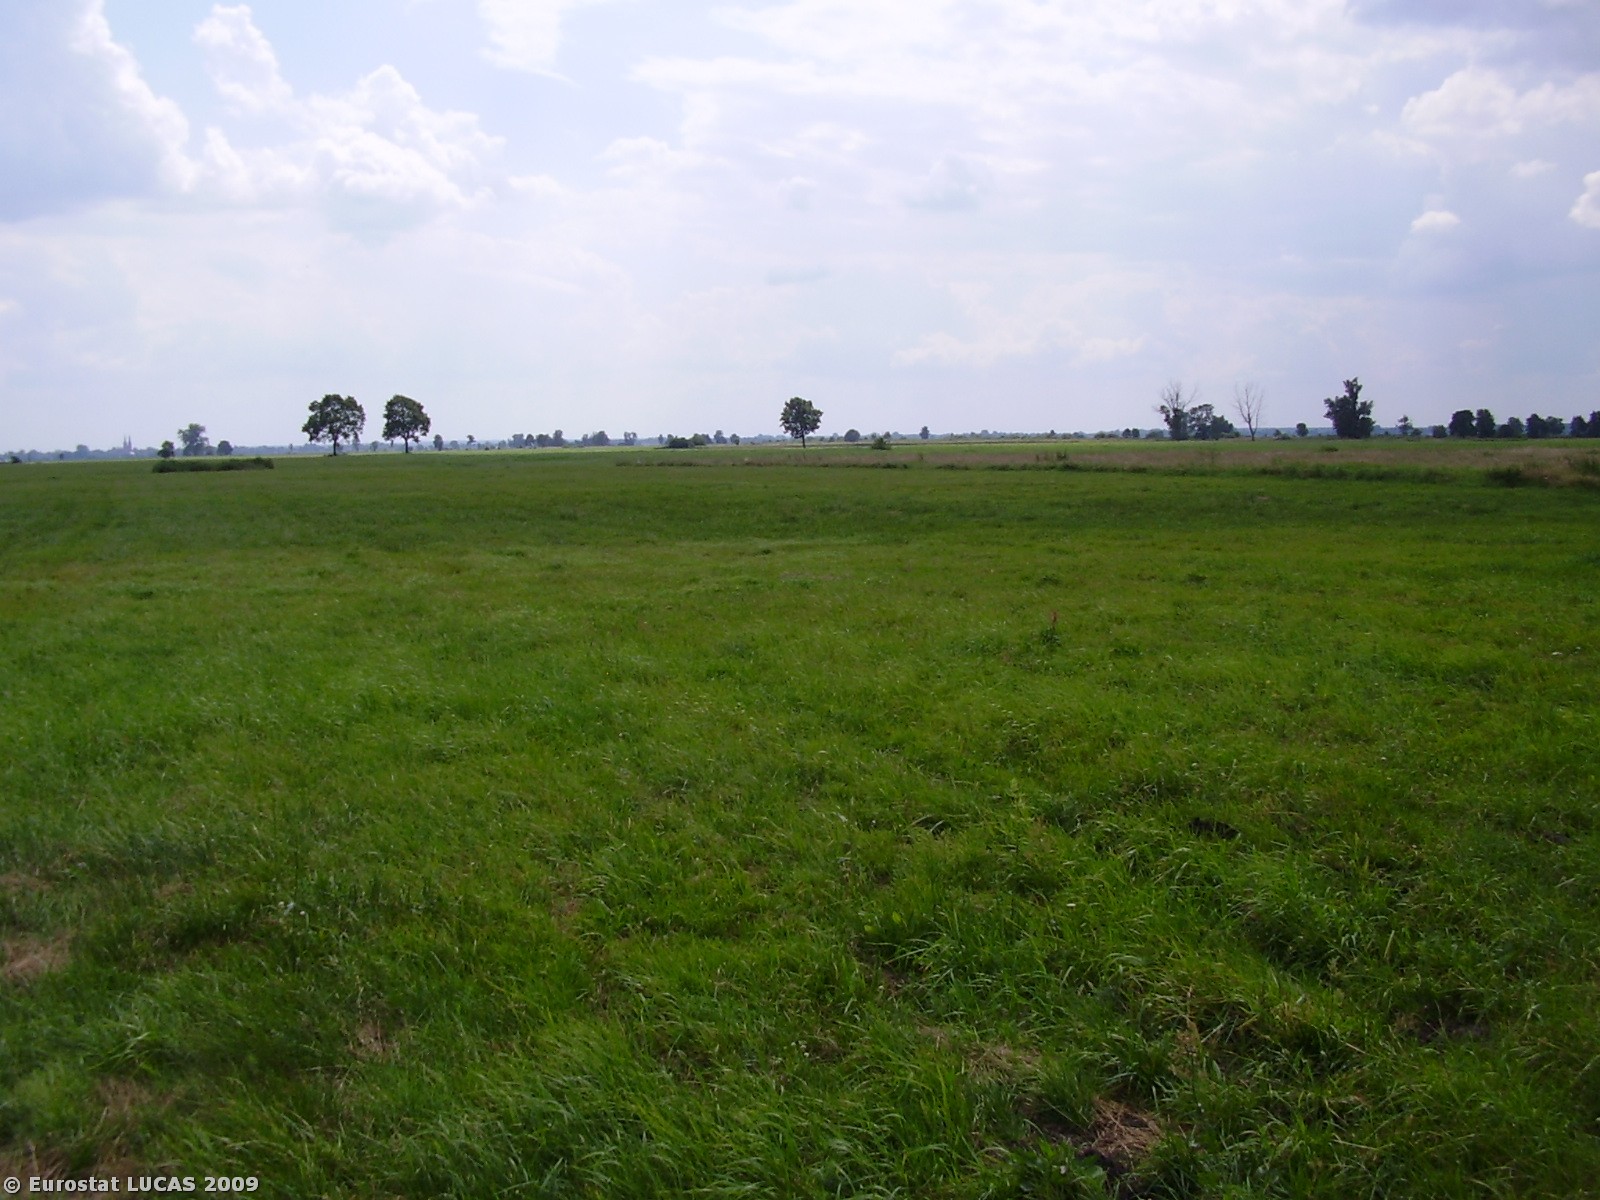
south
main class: Grassland
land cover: Grassland without tree/shrub cover
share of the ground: > 75 %
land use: Agriculture (excluding fallow land and kitchen gardens)
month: July
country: PL
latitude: 52.0499
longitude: 16.2624
